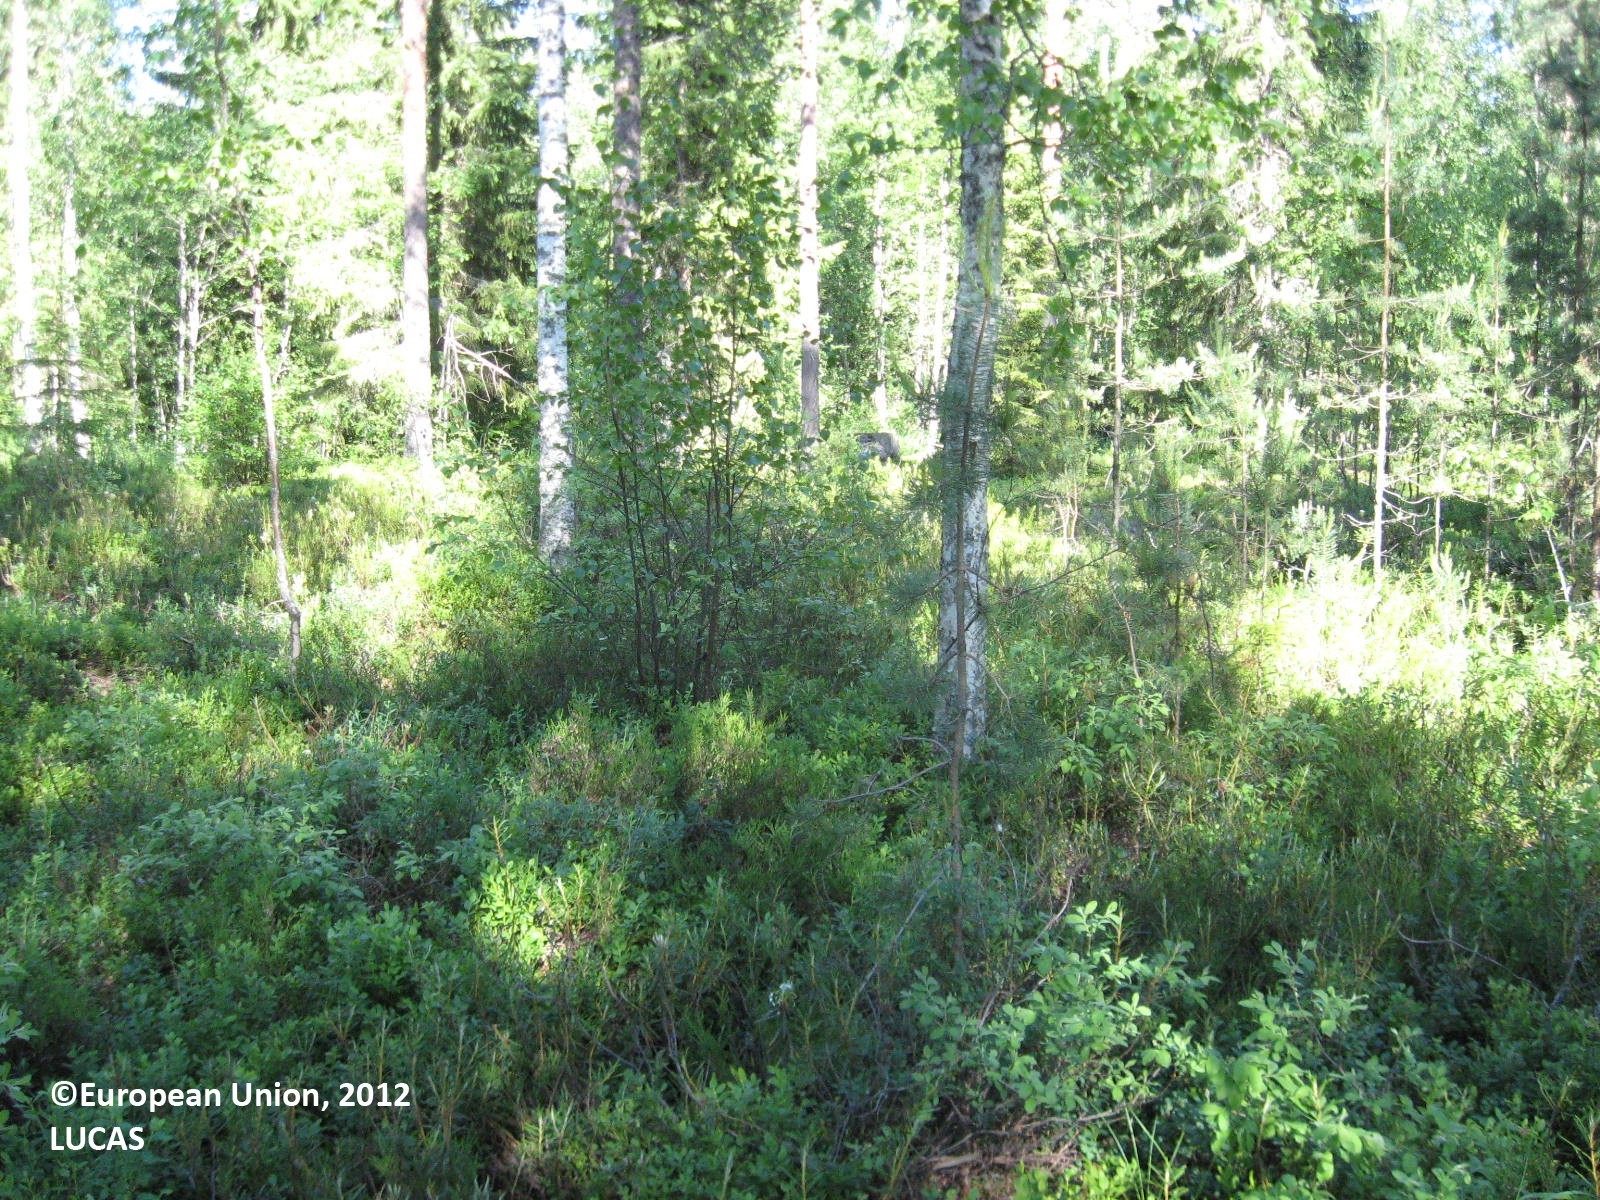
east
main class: Woodland
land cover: Other mixed woodland
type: boreal forest
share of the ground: > 75 %
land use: Forestry
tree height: > 5 m
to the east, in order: Other mixed woodland; Pine dominated mixed woodland; Other mixed woodland; Ditches and canals; Other mixed woodland; Ditches and canals; Other mixed woodland; Ditches and canals; Pine dominated mixed woodland; Ditches and canals; Other mixed woodland; Ditches and canals; Pine dominated coniferous woodland
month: July
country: FI
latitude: 62.6992
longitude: 22.8598
